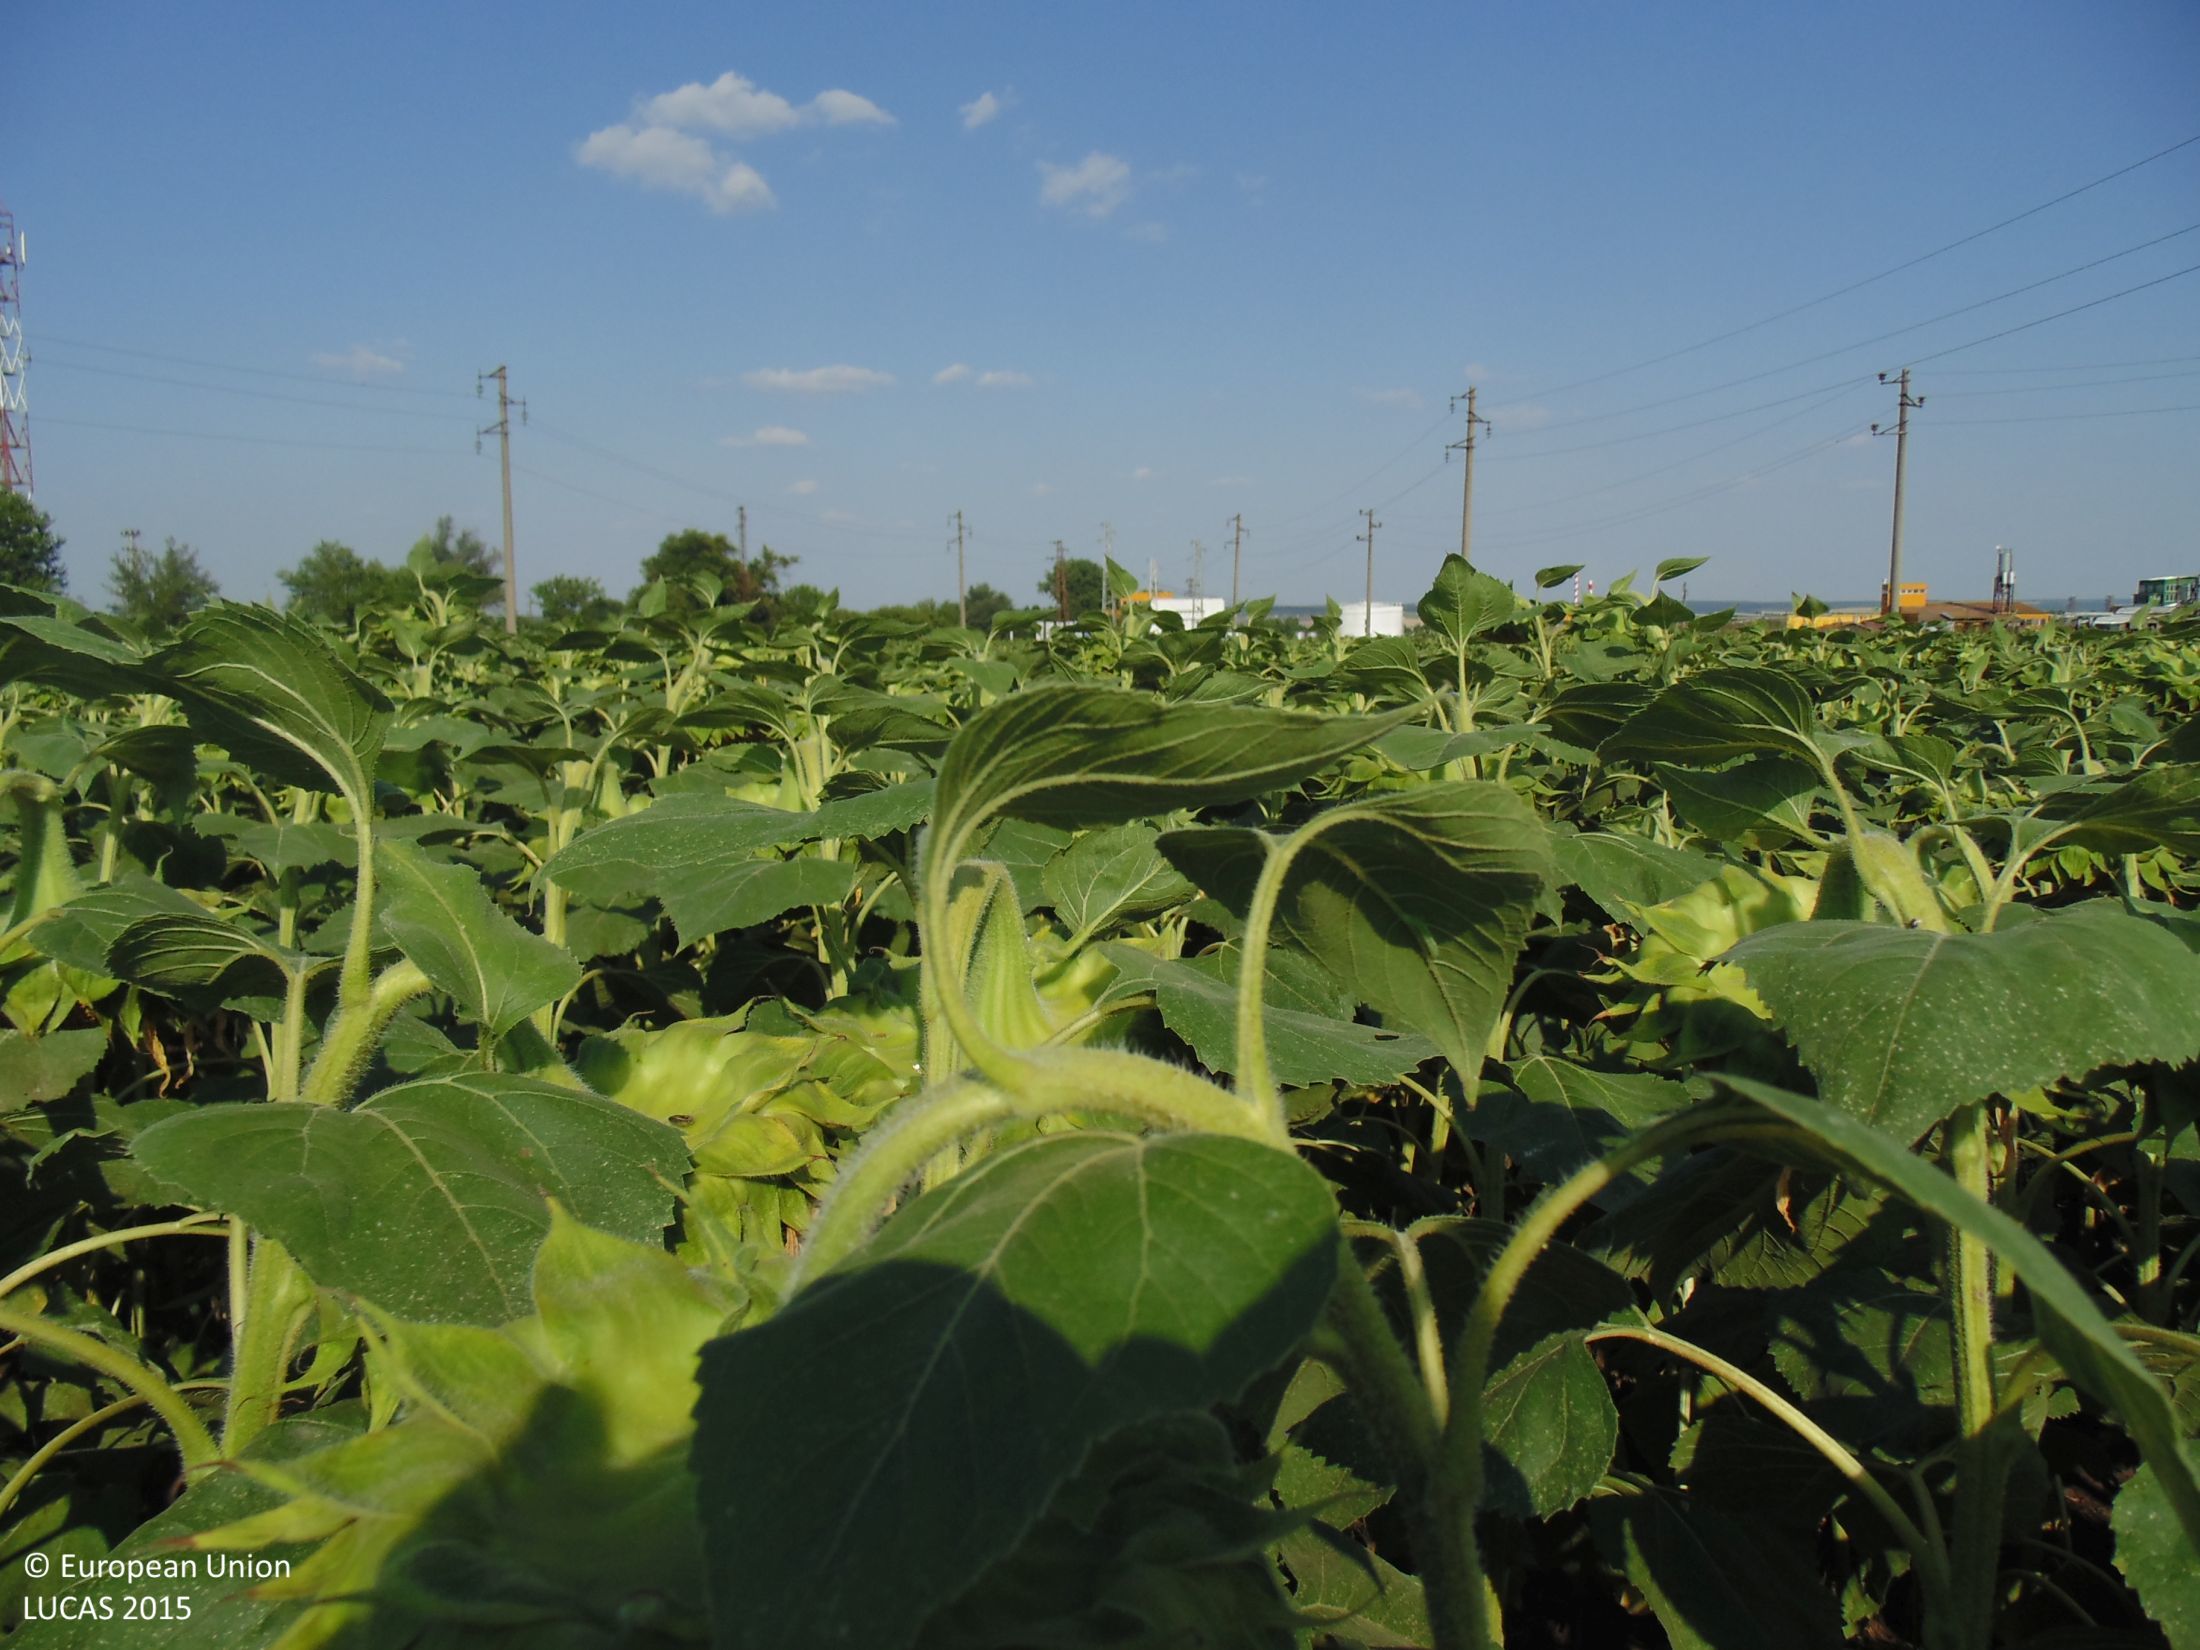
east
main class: Cropland
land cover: Sunflower
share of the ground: > 75 %
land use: Agriculture (excluding fallow land and kitchen gardens)
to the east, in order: Sunflower
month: July
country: BG
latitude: 43.6505
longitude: 27.5541
